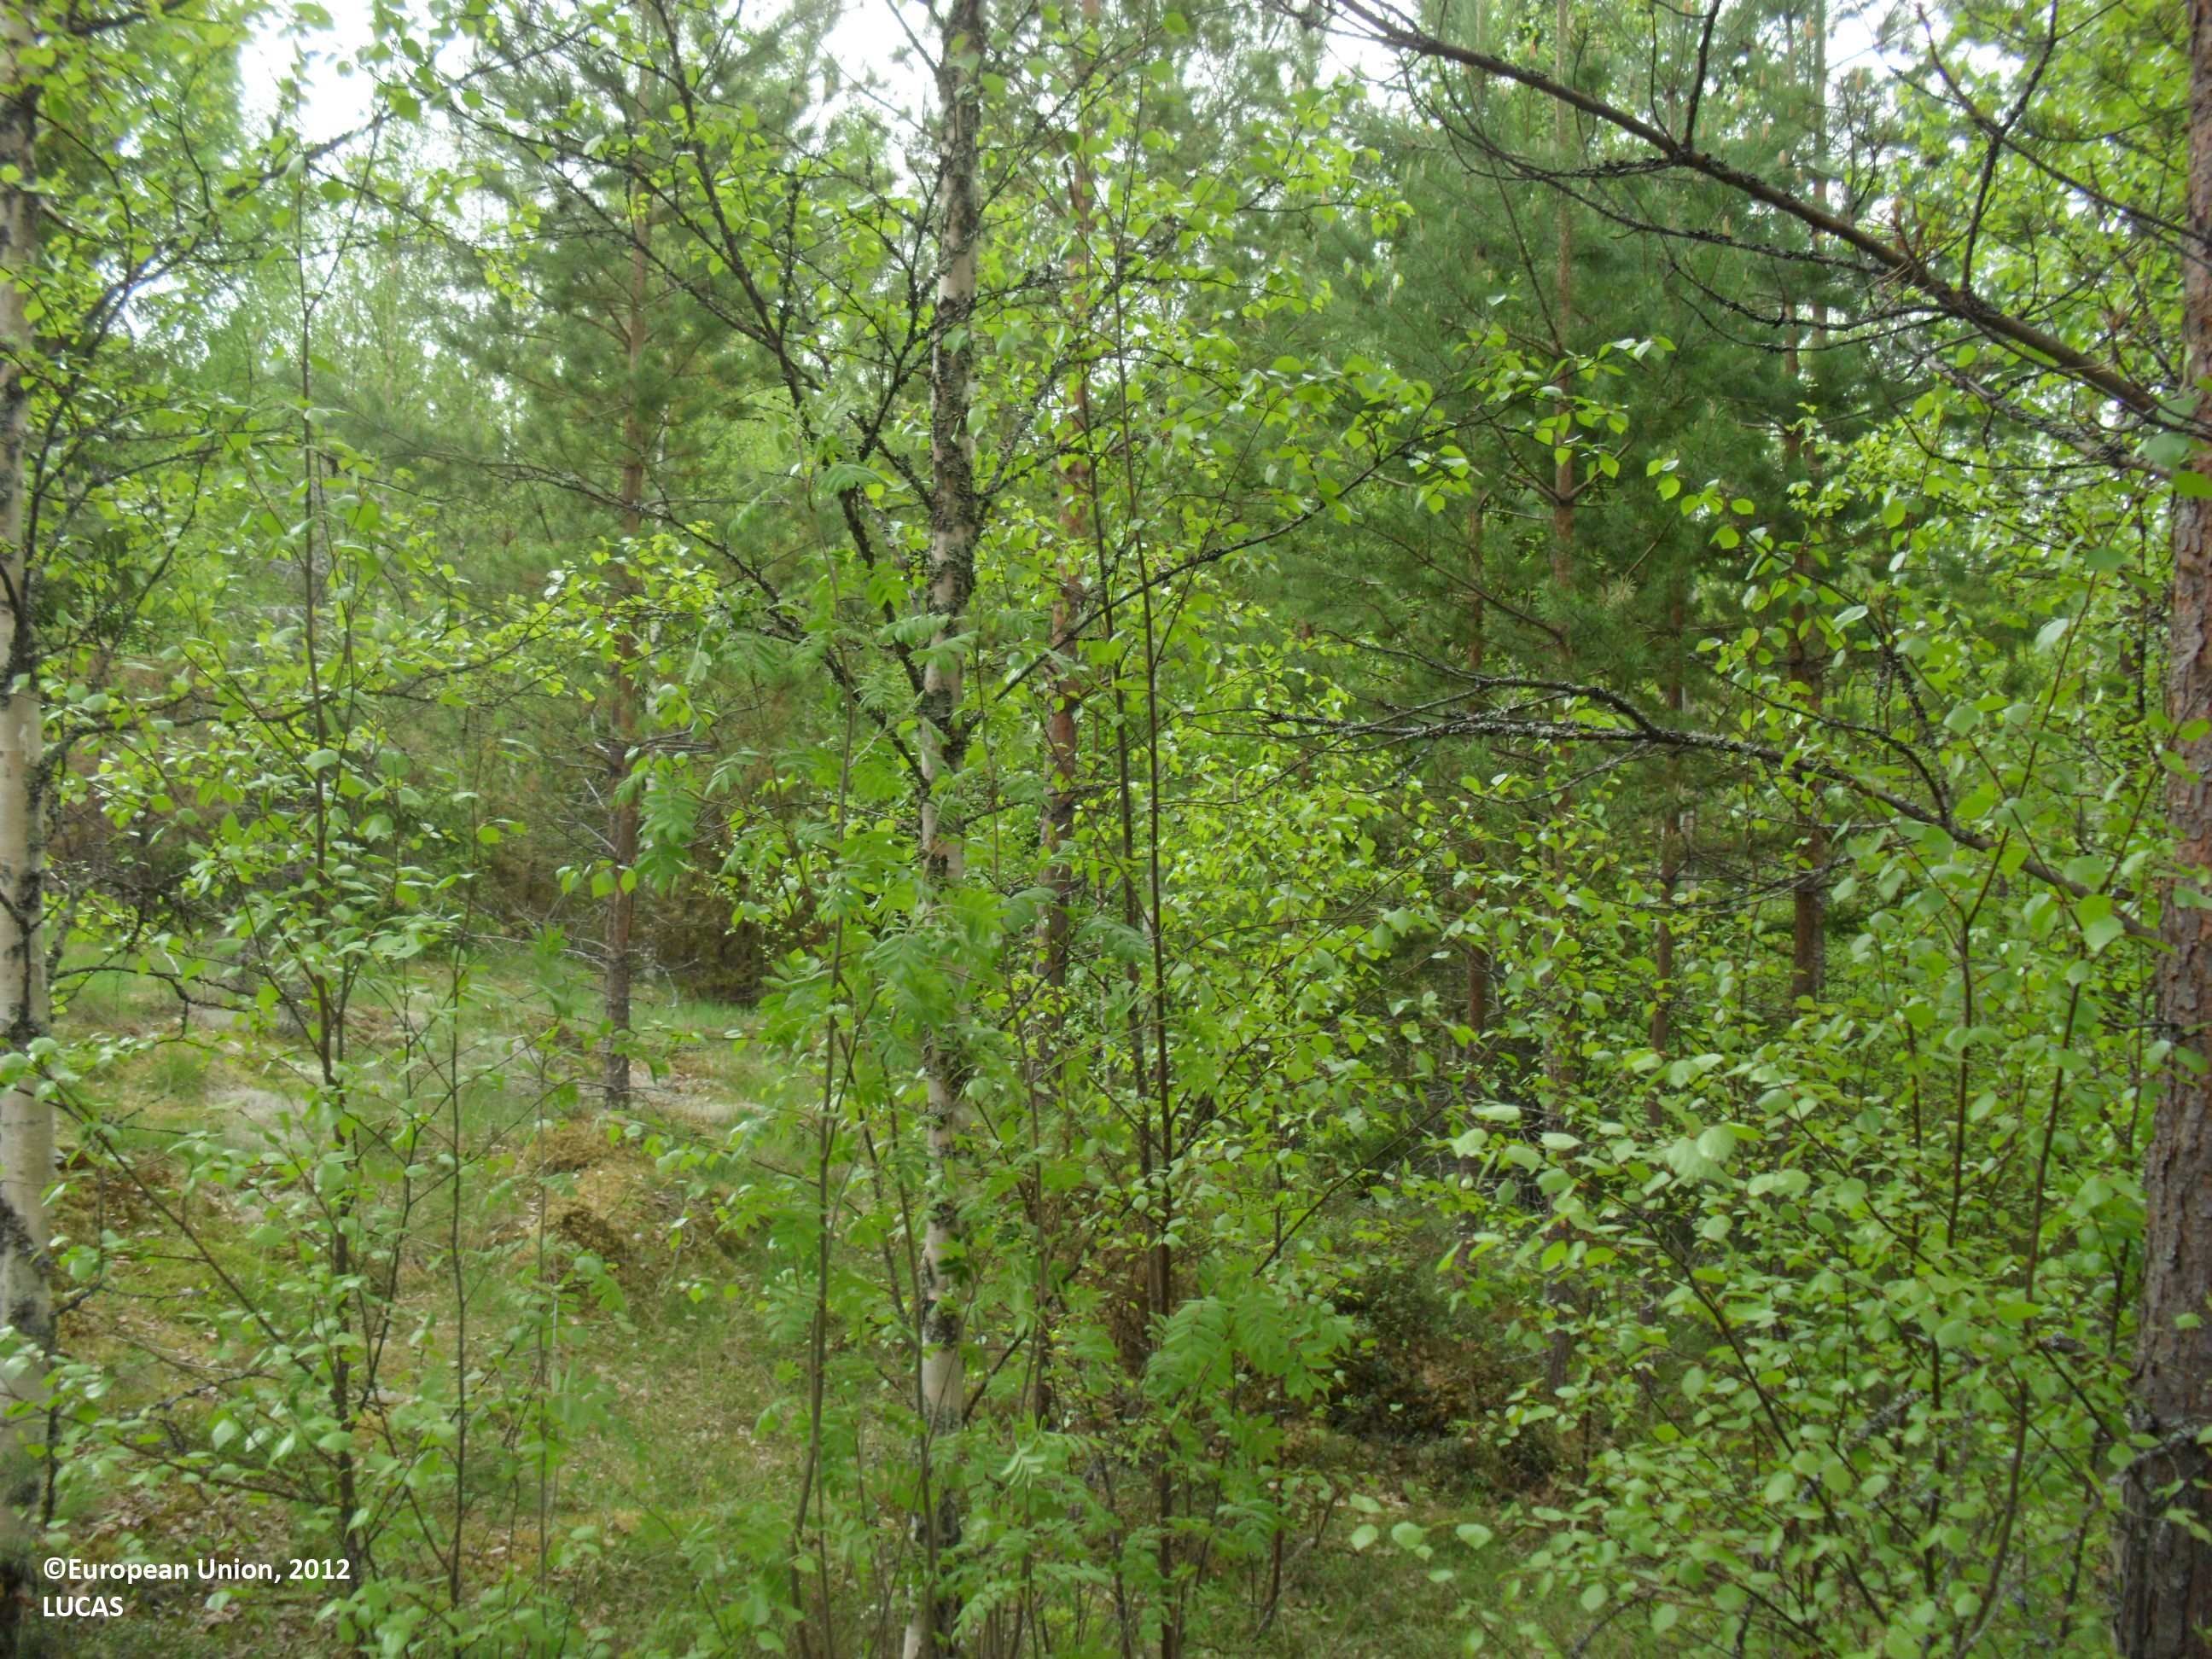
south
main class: Woodland
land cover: Pine dominated mixed woodland
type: boreal forest
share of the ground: 50 - 75 %
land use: Forestry
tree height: > 5 m
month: June
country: FI
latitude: 63.0172
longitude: 22.9982
